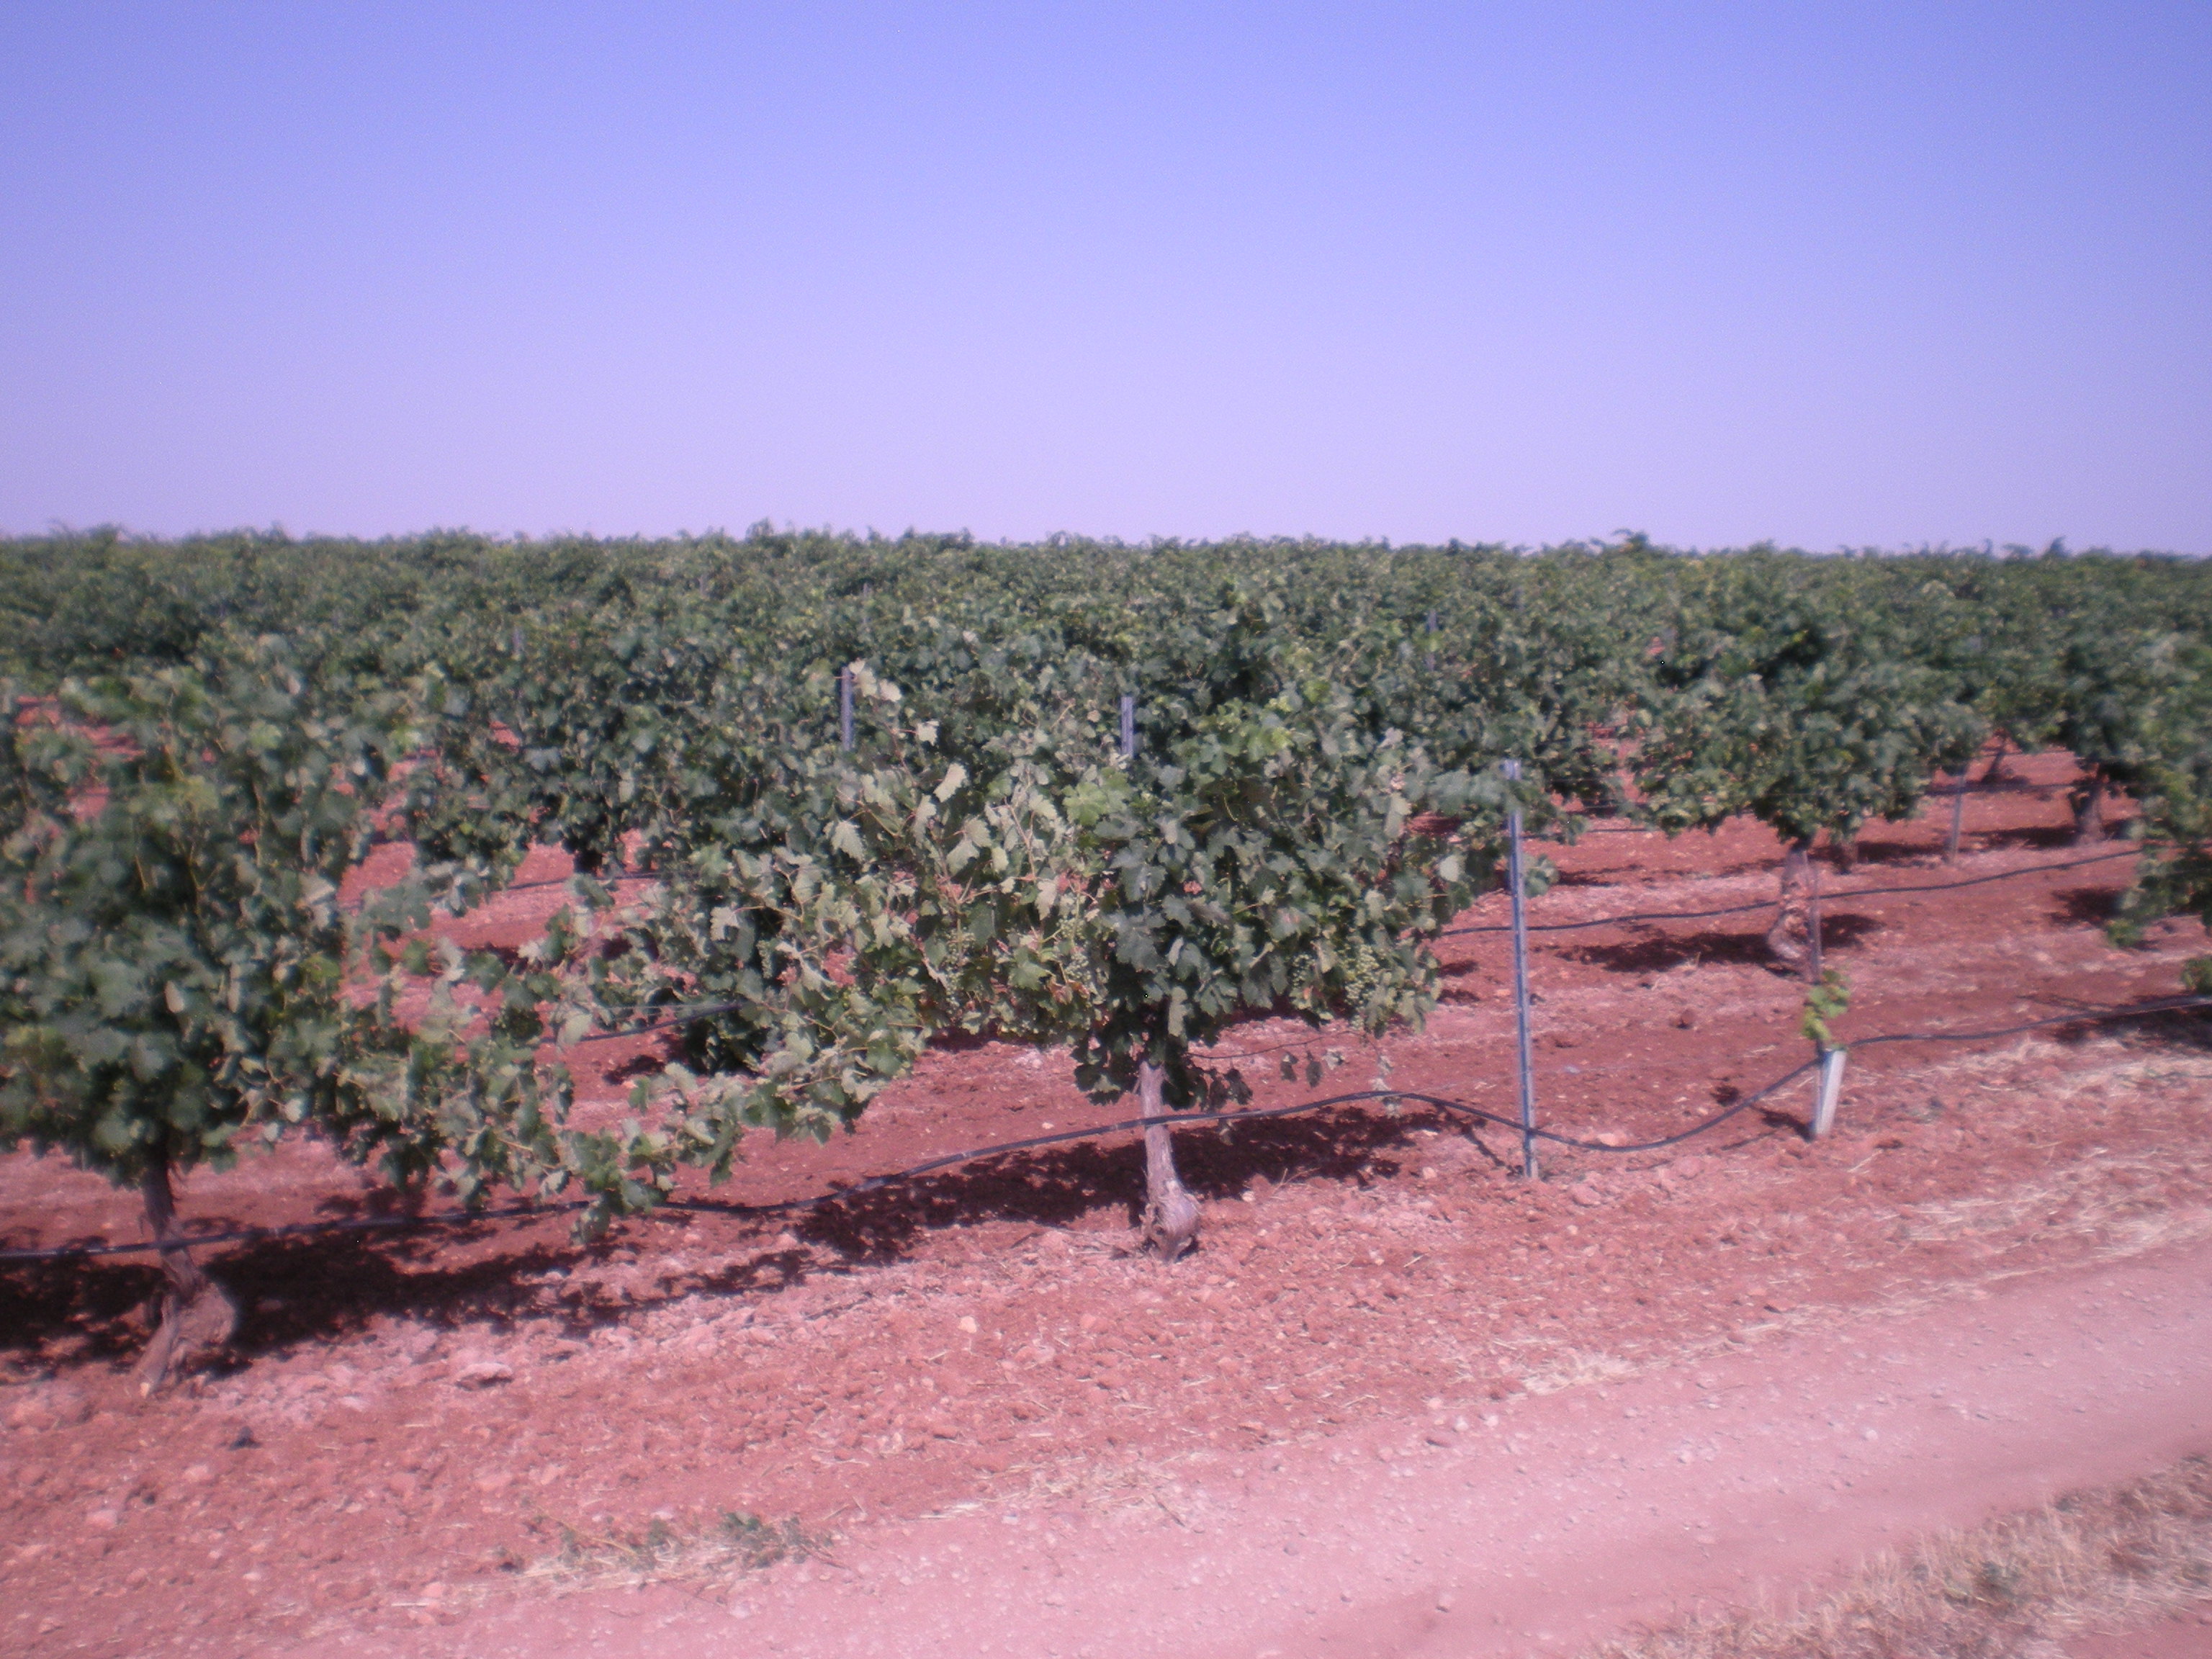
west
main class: Cropland
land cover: Barley
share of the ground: < 10 %
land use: Agriculture (excluding fallow land and kitchen gardens)
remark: Harvested field
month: July
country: ES
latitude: 39.4791
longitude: -3.2140
